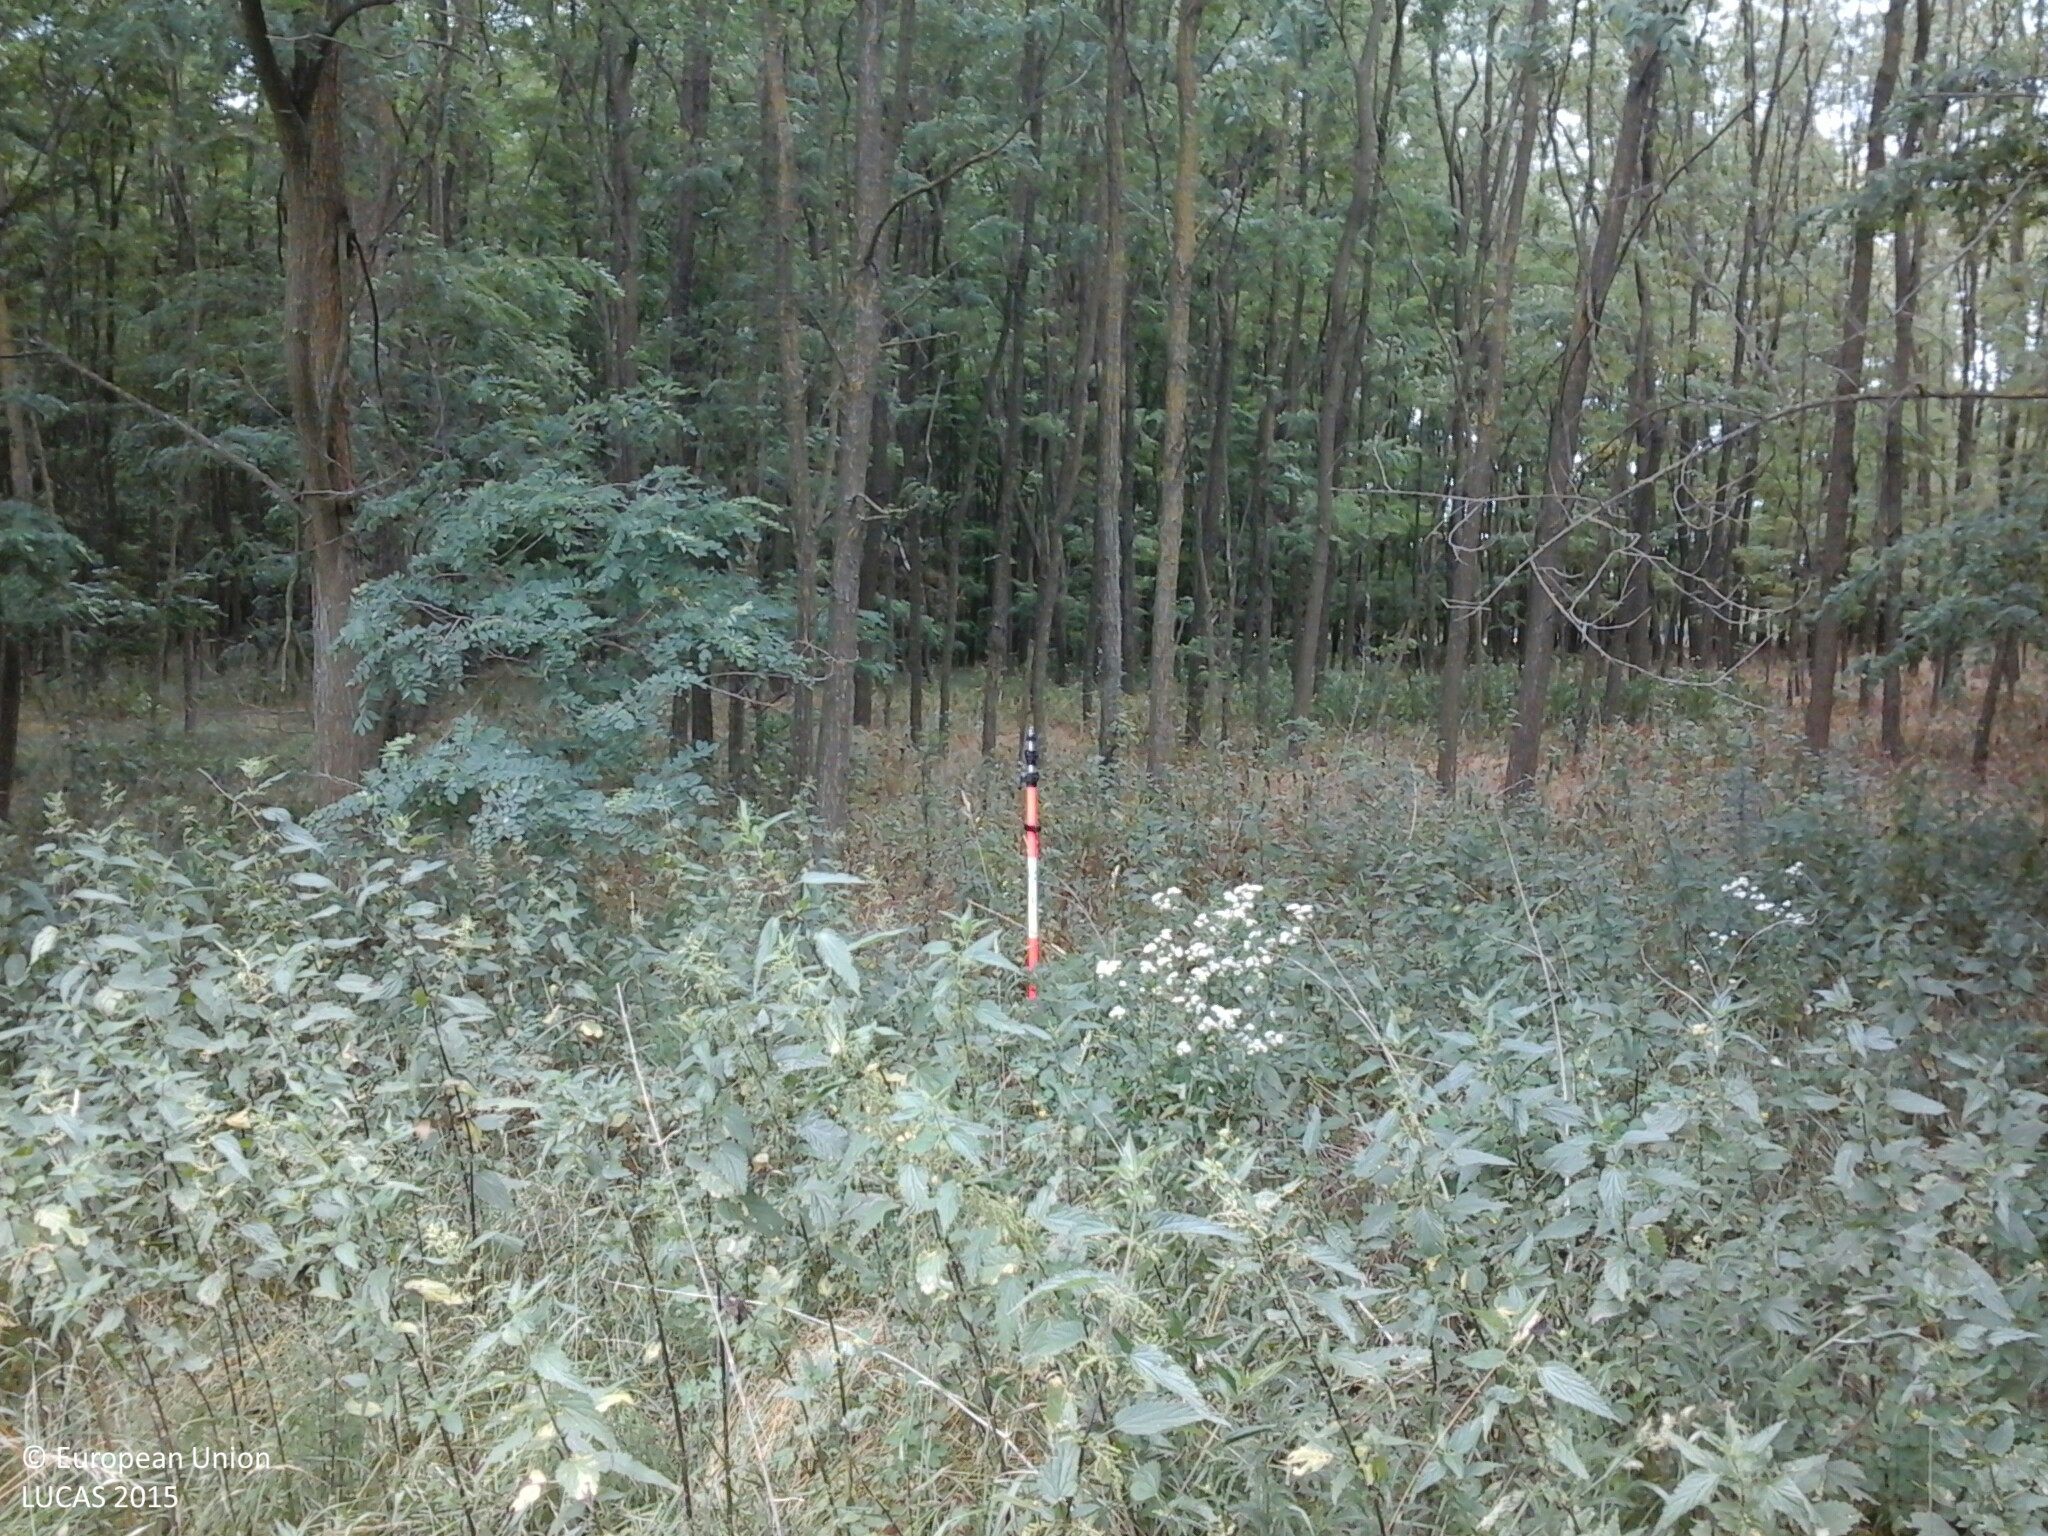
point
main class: Woodland
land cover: Broadleaved woodland
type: mesophytic deciduous forest
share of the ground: > 75 %
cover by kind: broadleaved forest trees 90 %, herbaceous plants 10 %
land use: Forestry
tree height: > 5 m
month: July
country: HU
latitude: 48.3628
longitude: 22.0261
